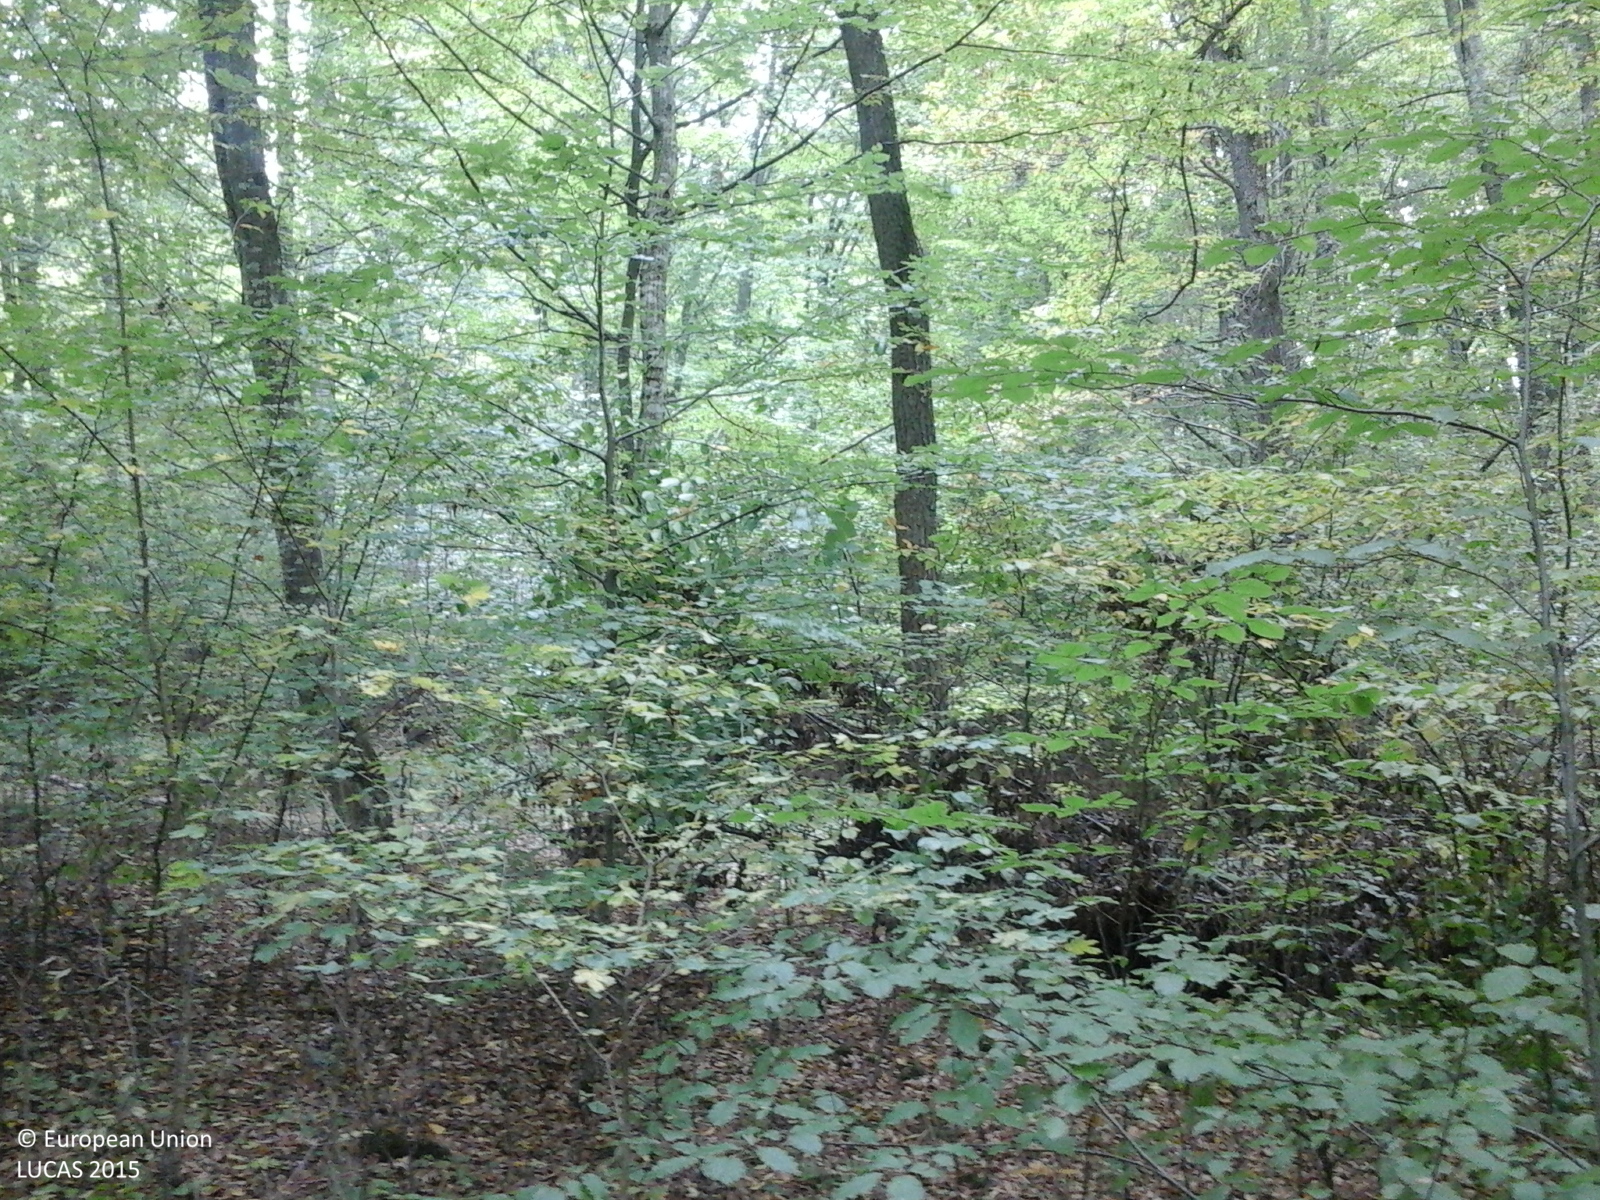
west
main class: Woodland
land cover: Broadleaved woodland
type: beech forest
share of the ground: > 75 %
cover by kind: broadleaved forest trees 100 %
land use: Forestry
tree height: > 5 m
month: October
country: RO
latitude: 46.0429
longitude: 25.3371
